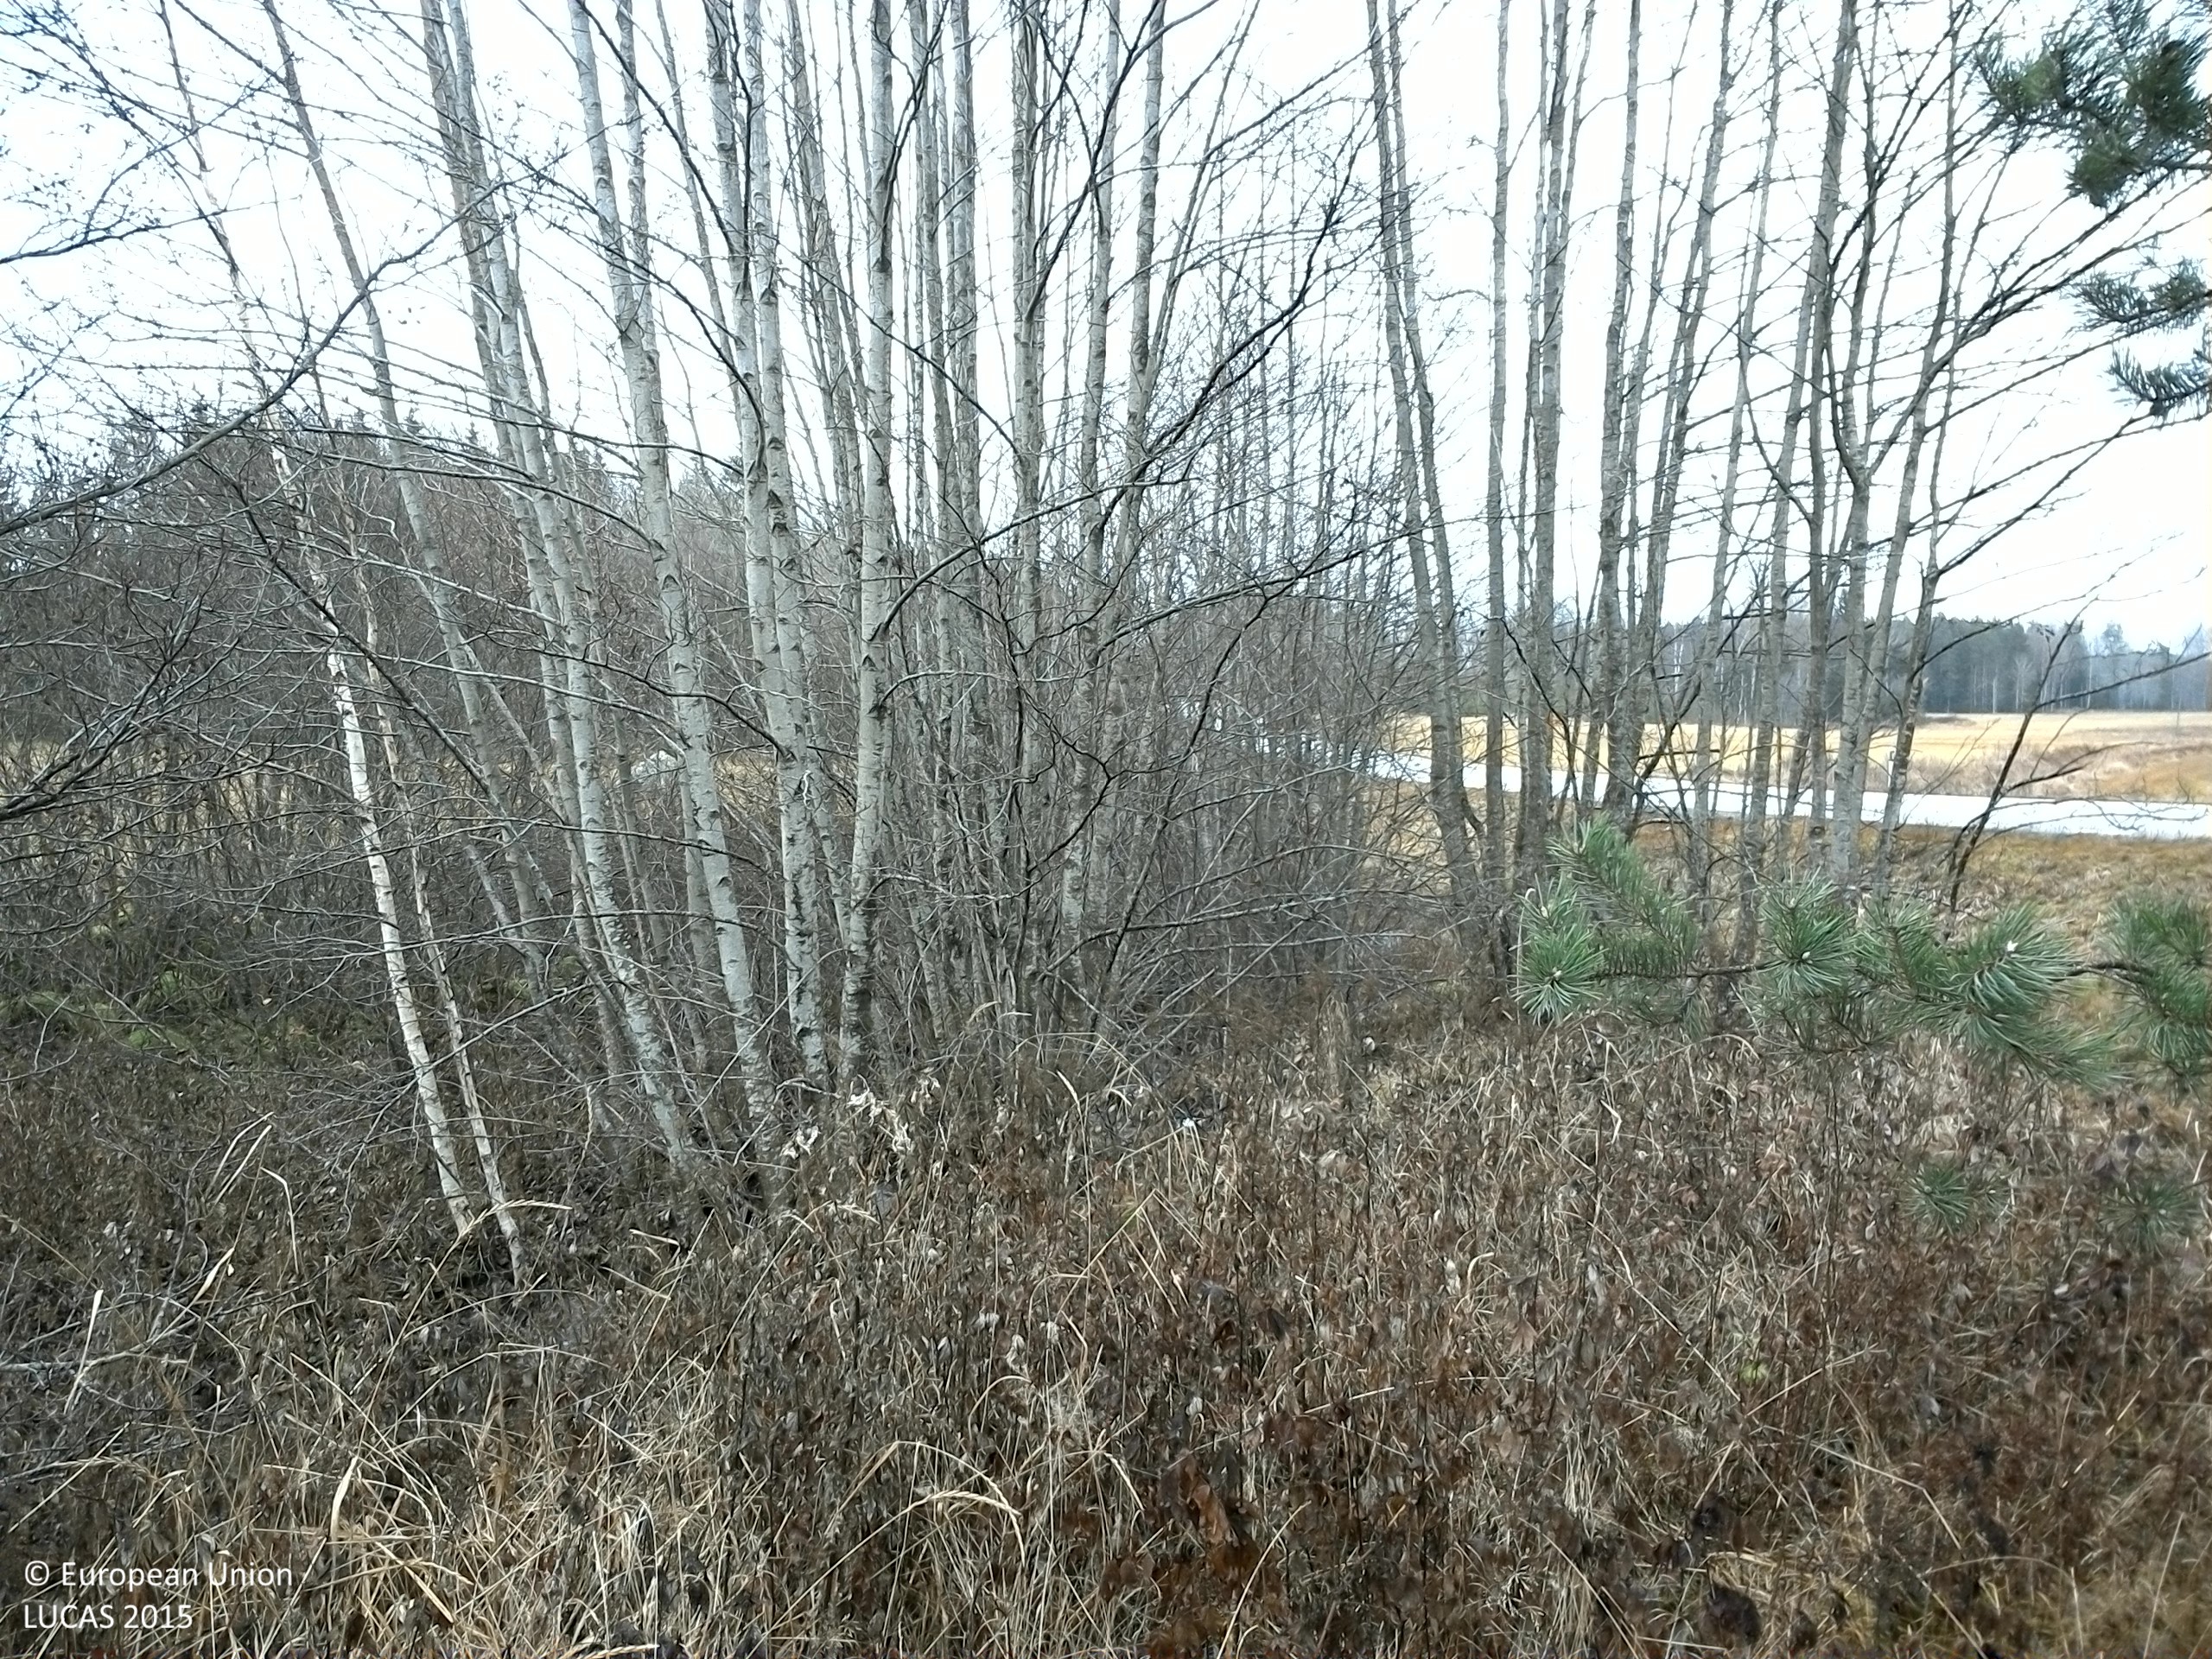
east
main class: Woodland
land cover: Pine dominated mixed woodland
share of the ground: 50 - 75 %
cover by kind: herbaceous plants 45 %, broadleaved forest trees 35 %, coniferous forest trees 20 %
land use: Semi-natural and natural areas not in use
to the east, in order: Pine dominated mixed woodland; Broadleaved woodland; Rivers and streams; Broadleaved woodland; Grassland without tree/shrub cover; Broadleaved woodland; Ditches and canals; Grassland without tree/shrub cover; Electric lines; Grassland without tree/shrub cover
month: November
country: SE
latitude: 59.2176
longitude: 16.8792
